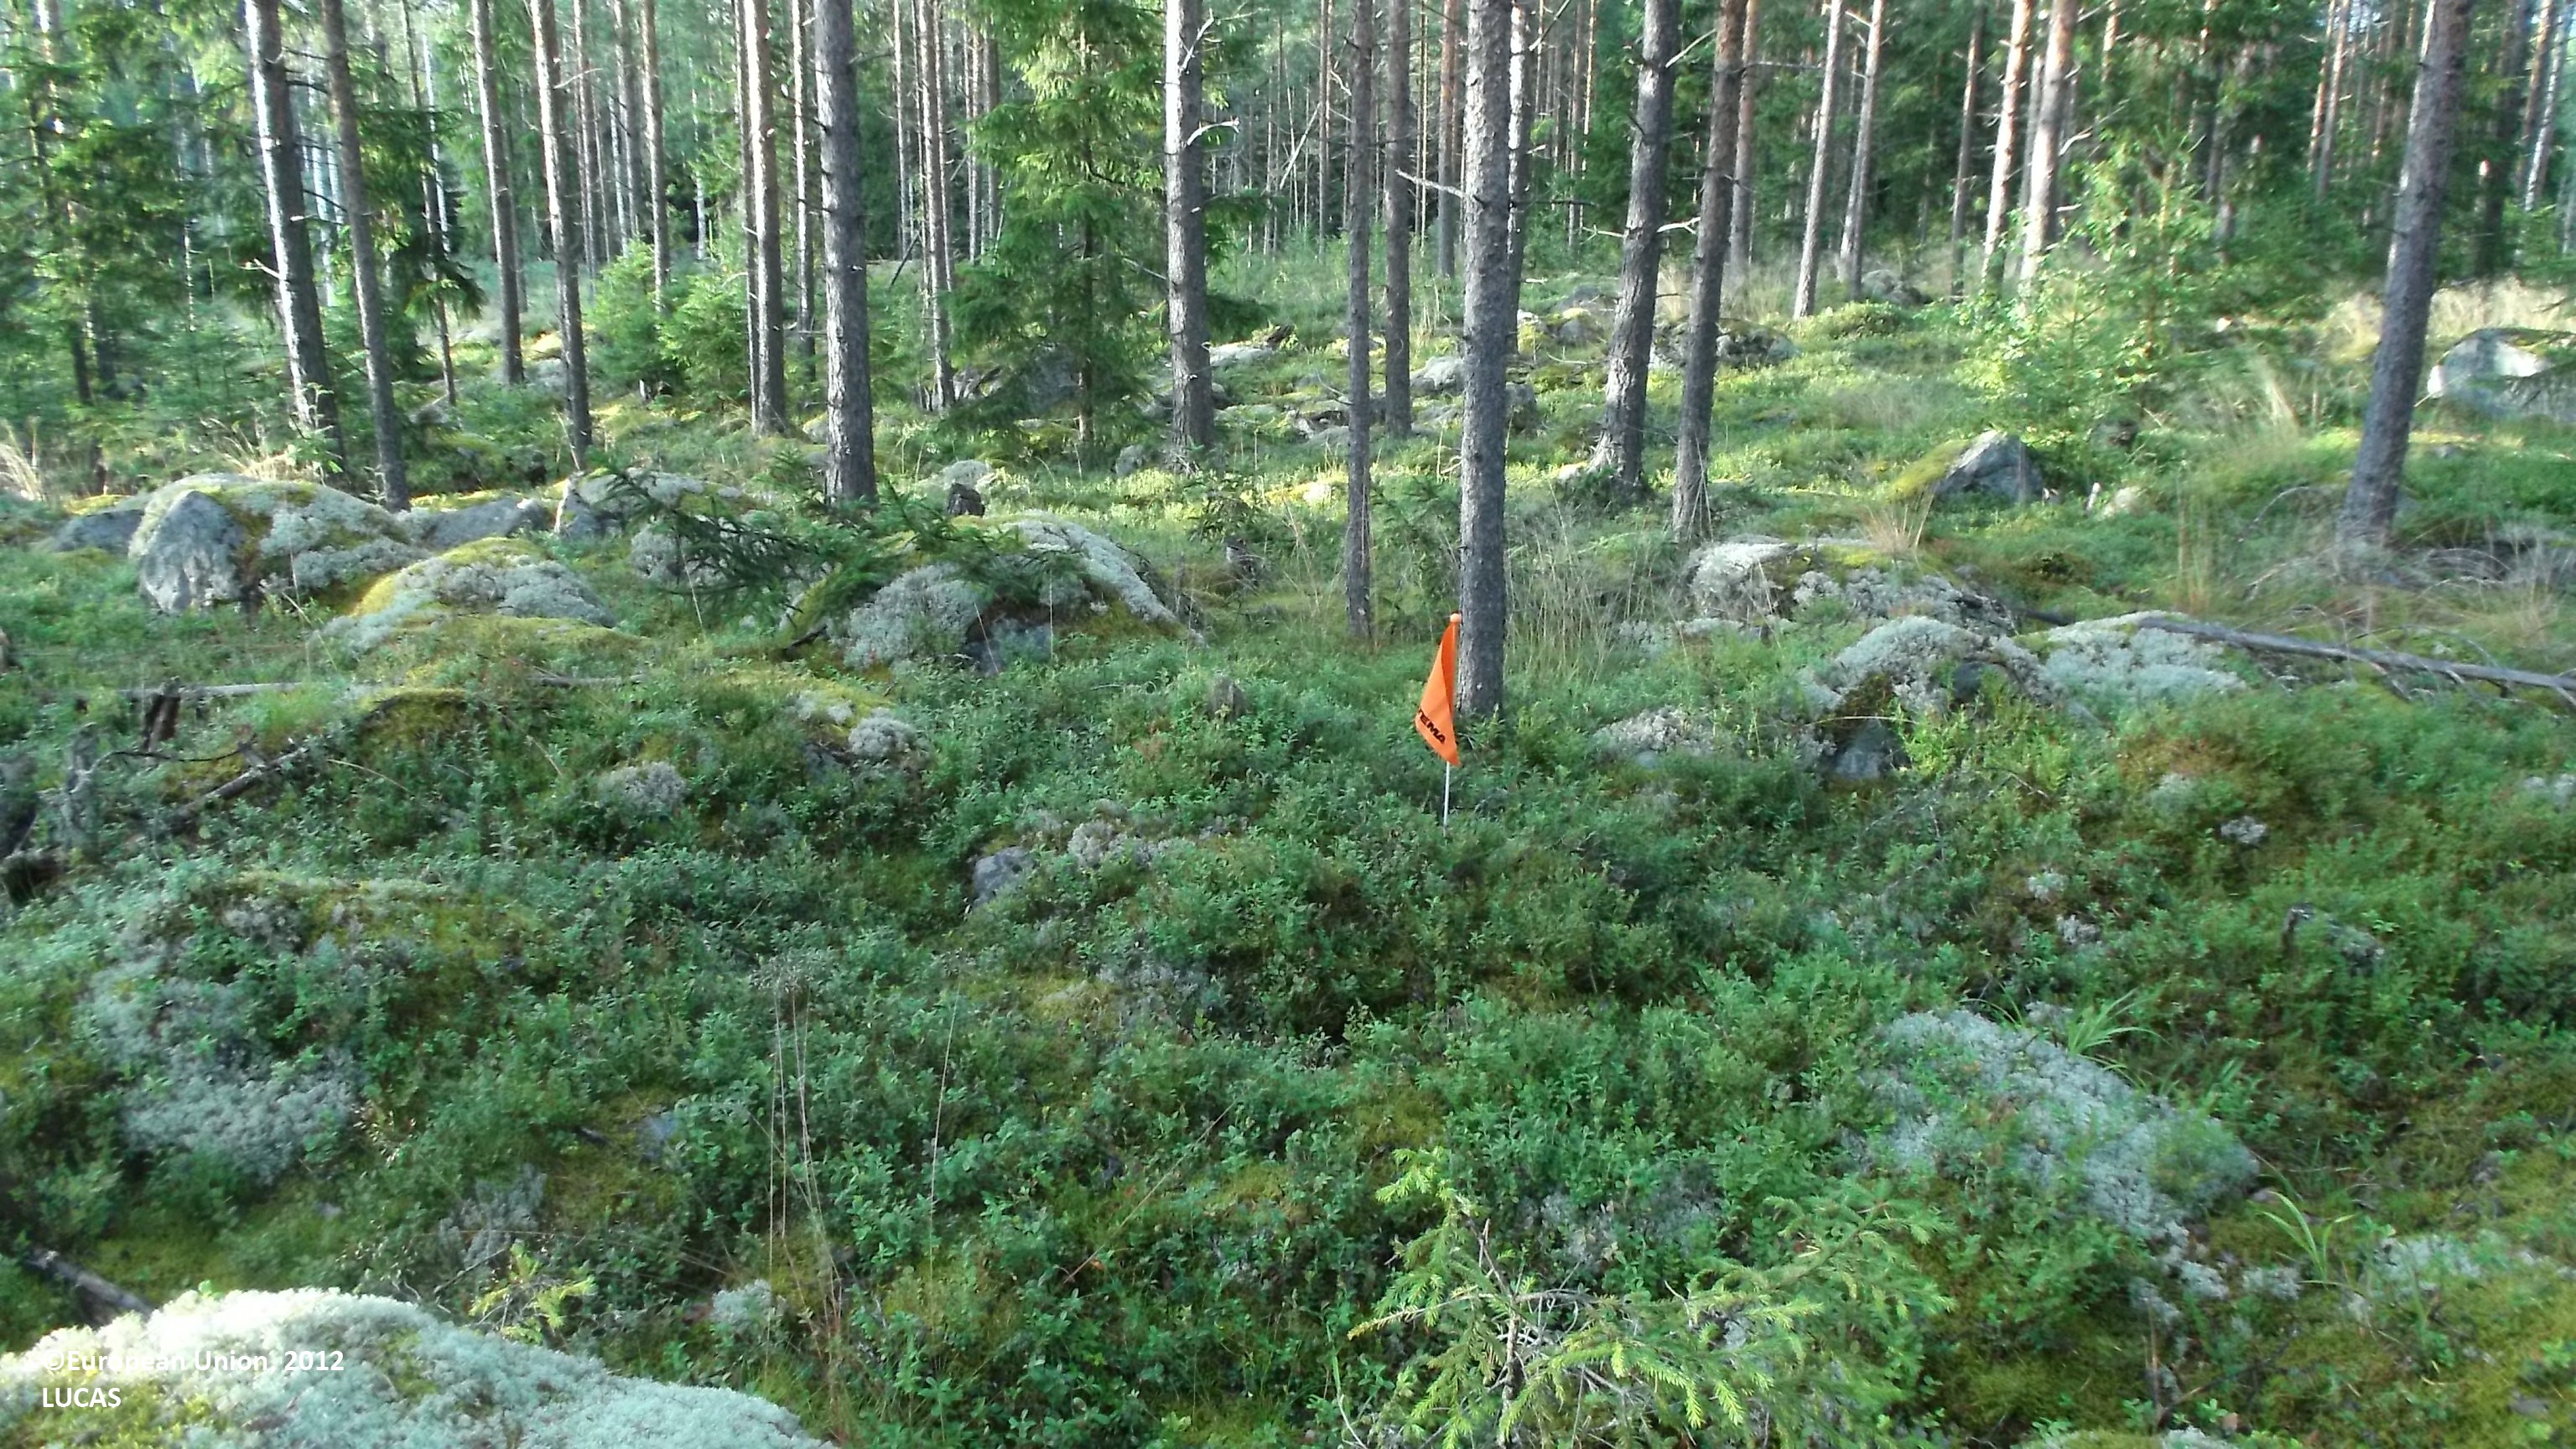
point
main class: Woodland
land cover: Pine dominated coniferous woodland
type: boreal forest
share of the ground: 25 - 50 %
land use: Forestry
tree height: > 5 m
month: August
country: FI
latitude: 63.8717
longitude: 23.3048
